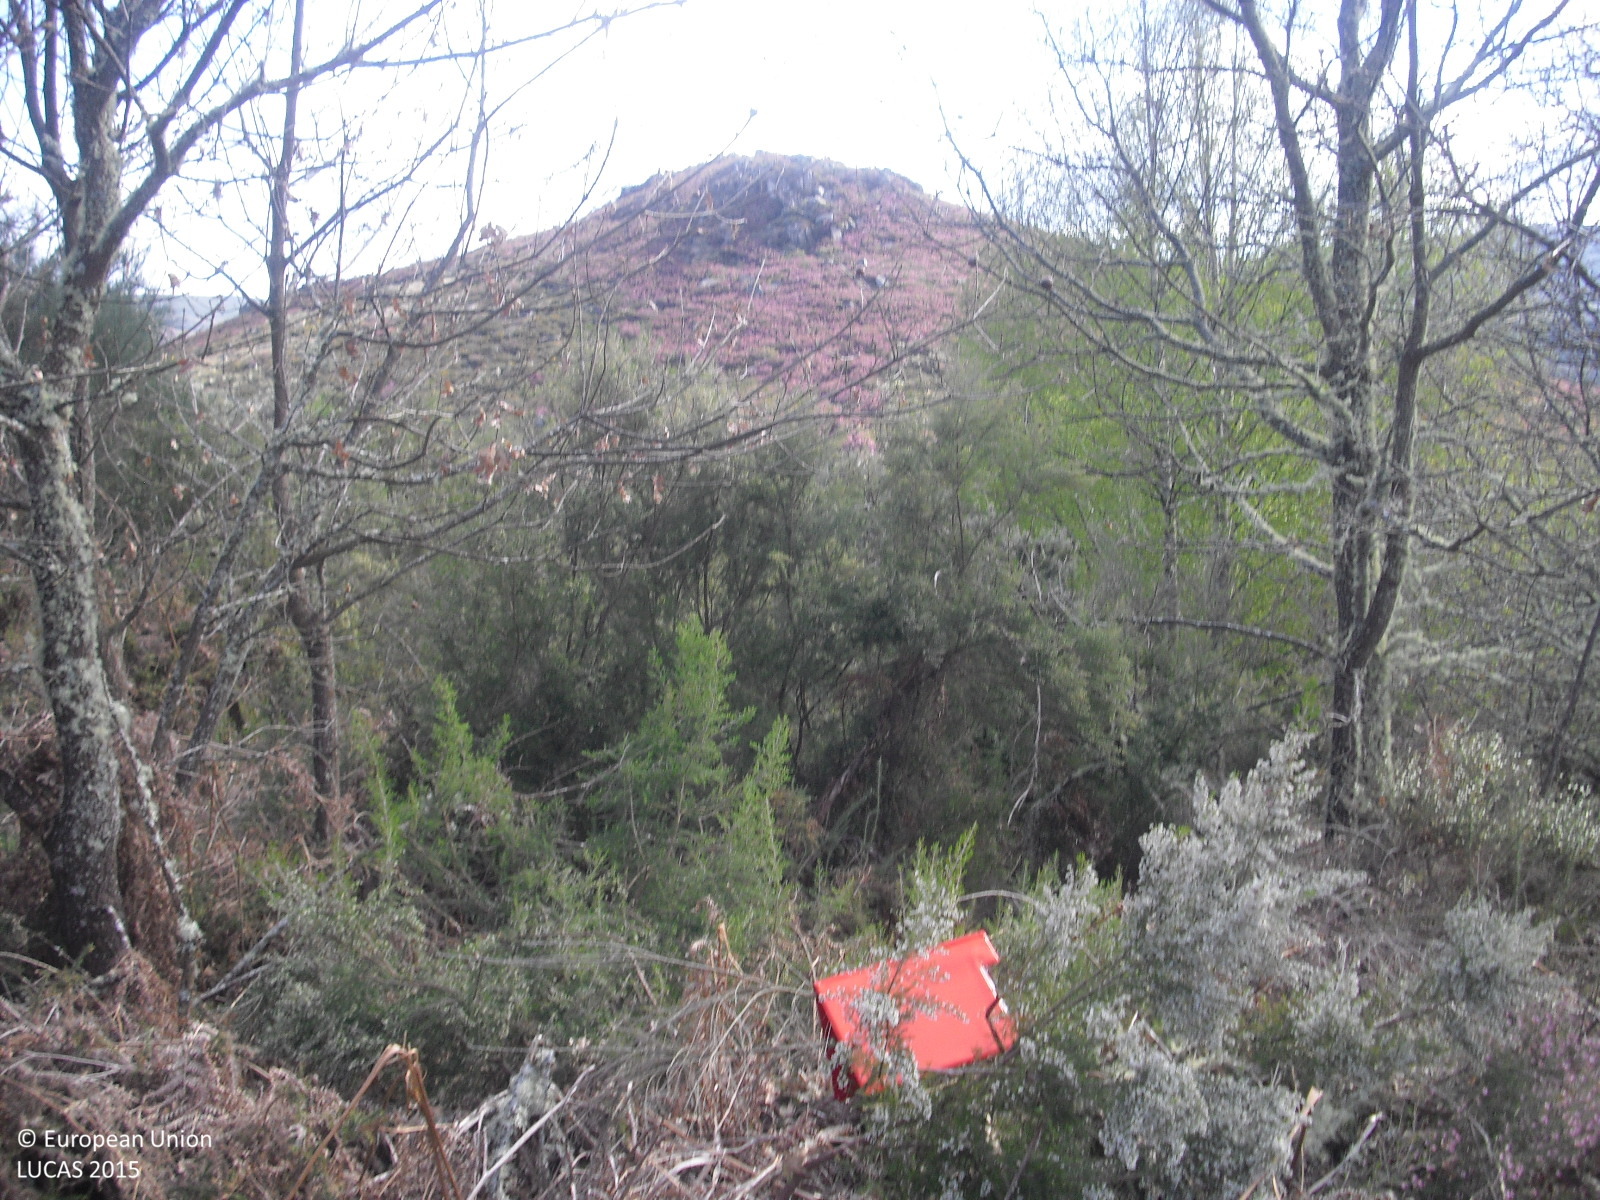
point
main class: Woodland
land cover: Broadleaved woodland
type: acidophilous oak and oak-birch forest
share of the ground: 25 - 50 %
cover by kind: shrubs 50 %, broadleaved forest trees 40 %, herbaceous plants 10 %
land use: Semi-natural and natural areas not in use
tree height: > 5 m
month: April
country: ES
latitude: 41.9193
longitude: -7.8559
